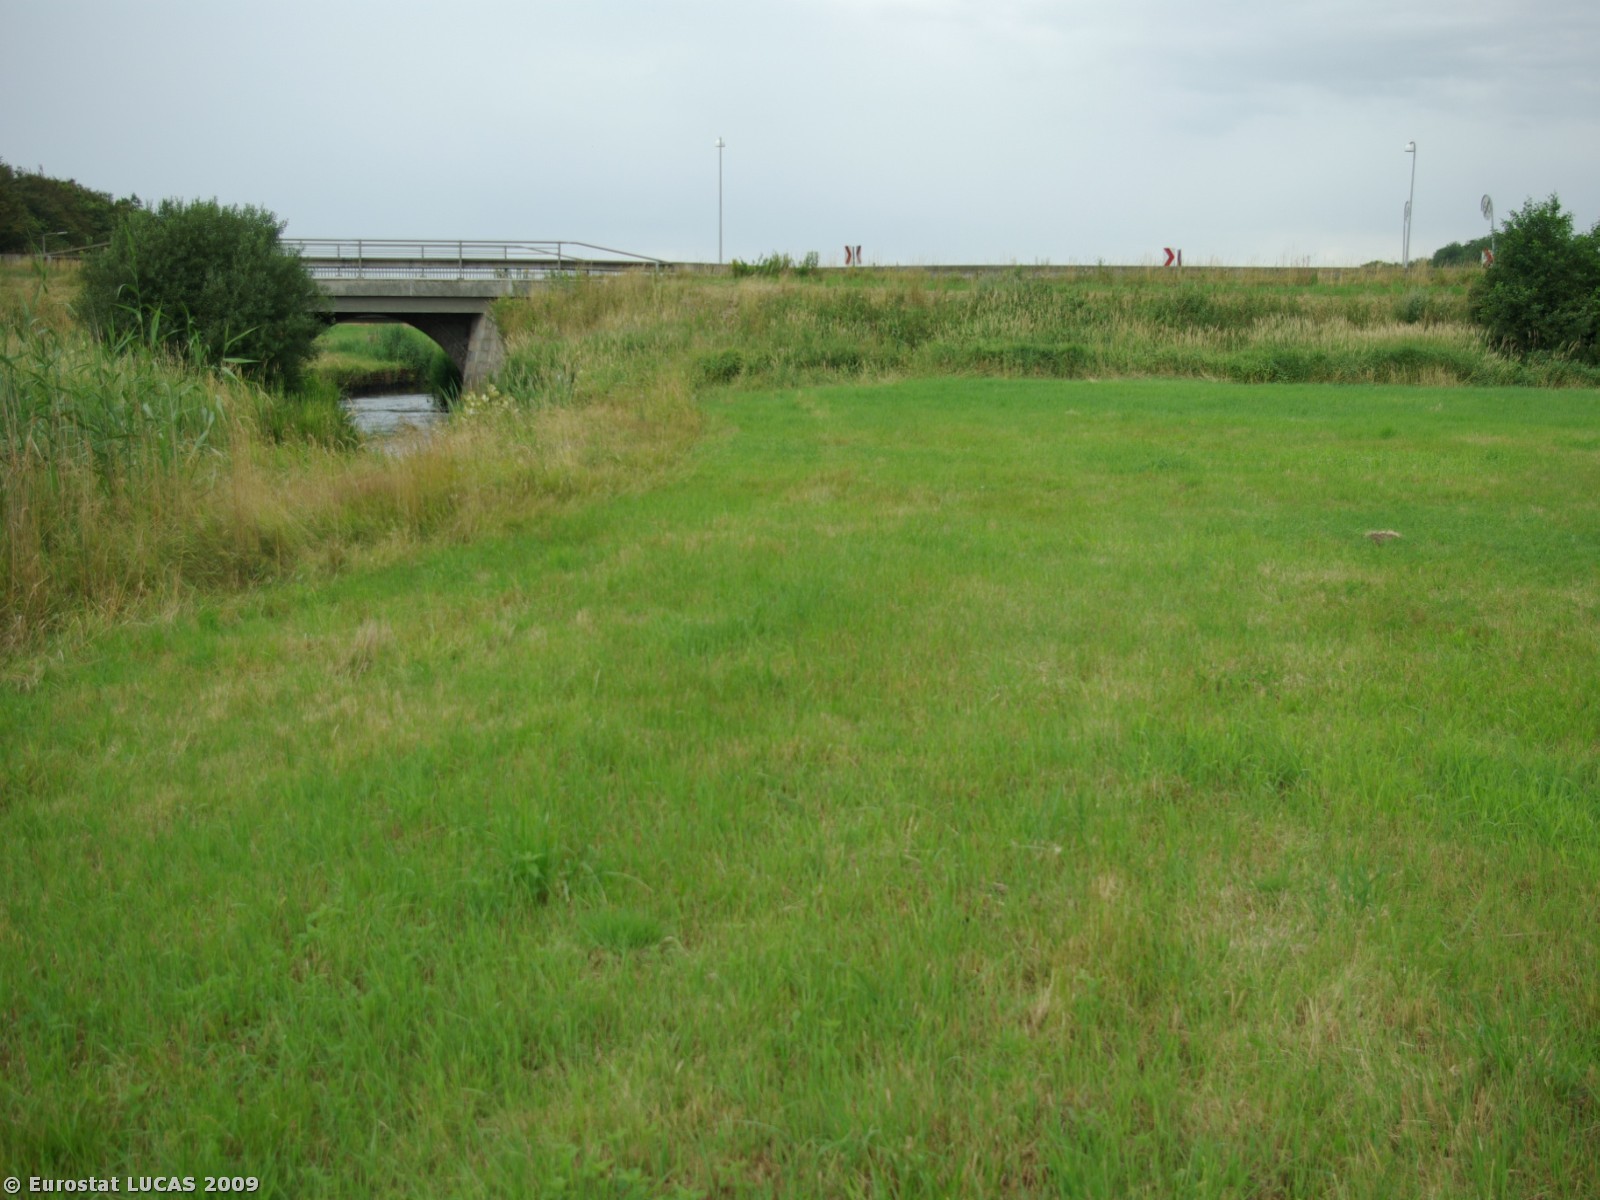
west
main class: Grassland
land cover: Grassland without tree/shrub cover
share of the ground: > 75 %
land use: Agriculture (excluding fallow land and kitchen gardens)
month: July
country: DK
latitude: 55.1927
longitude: 8.7286
